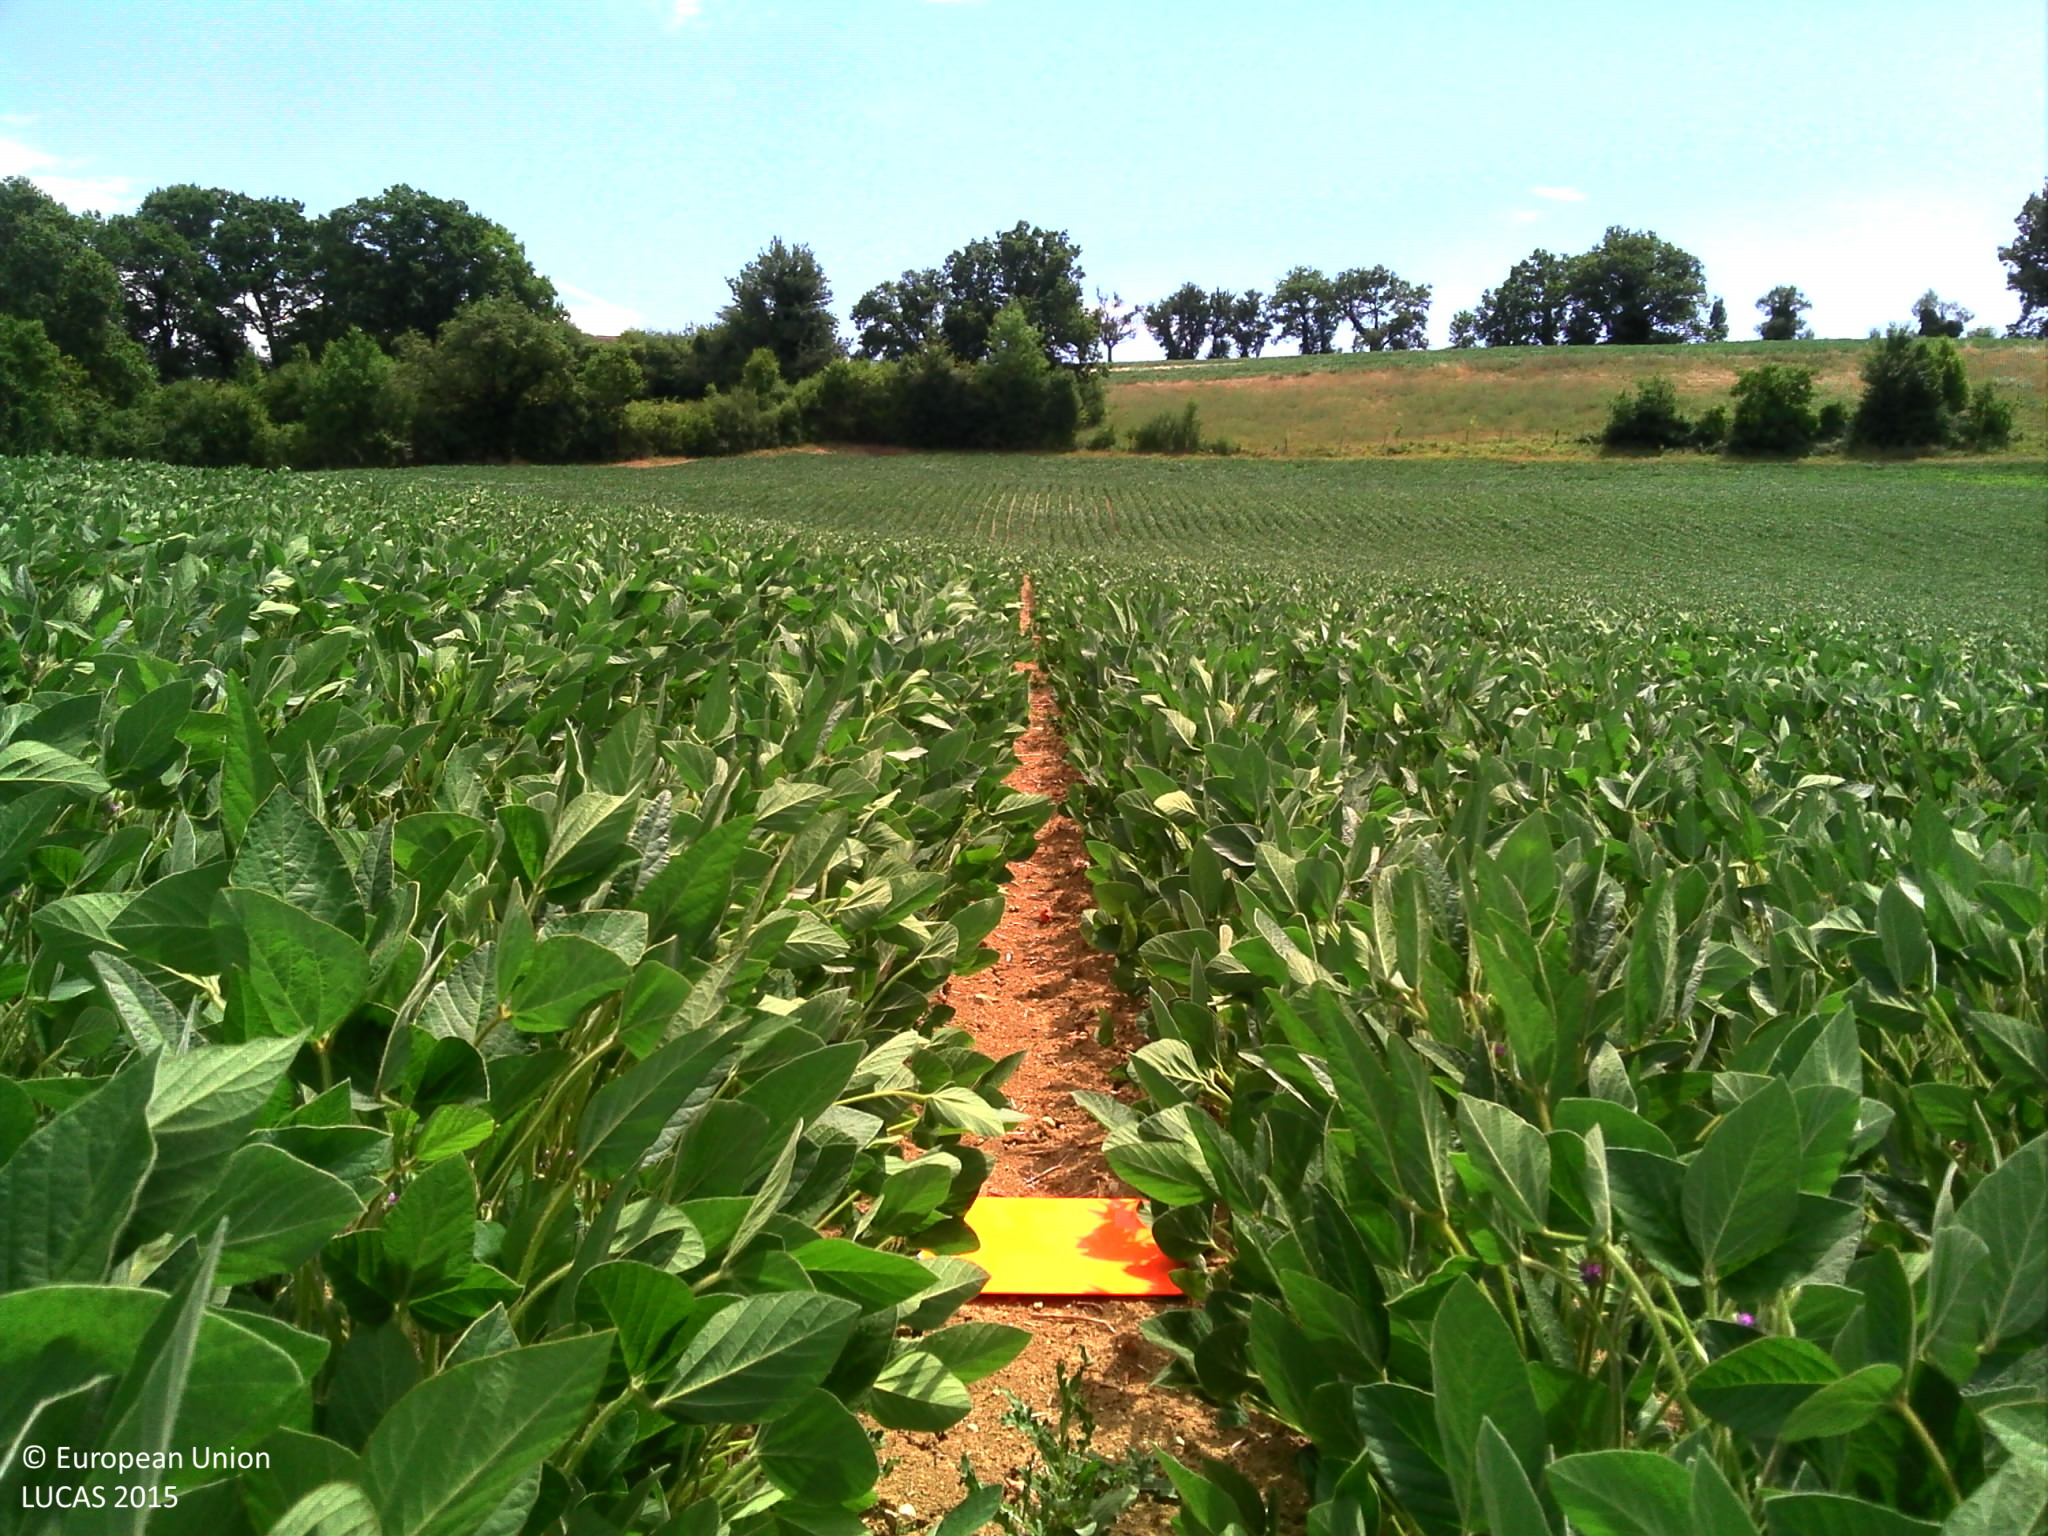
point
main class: Cropland
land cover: Soya
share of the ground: > 75 %
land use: Agriculture (excluding fallow land and kitchen gardens)
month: July
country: FR
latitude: 44.6442
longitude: 0.5483
